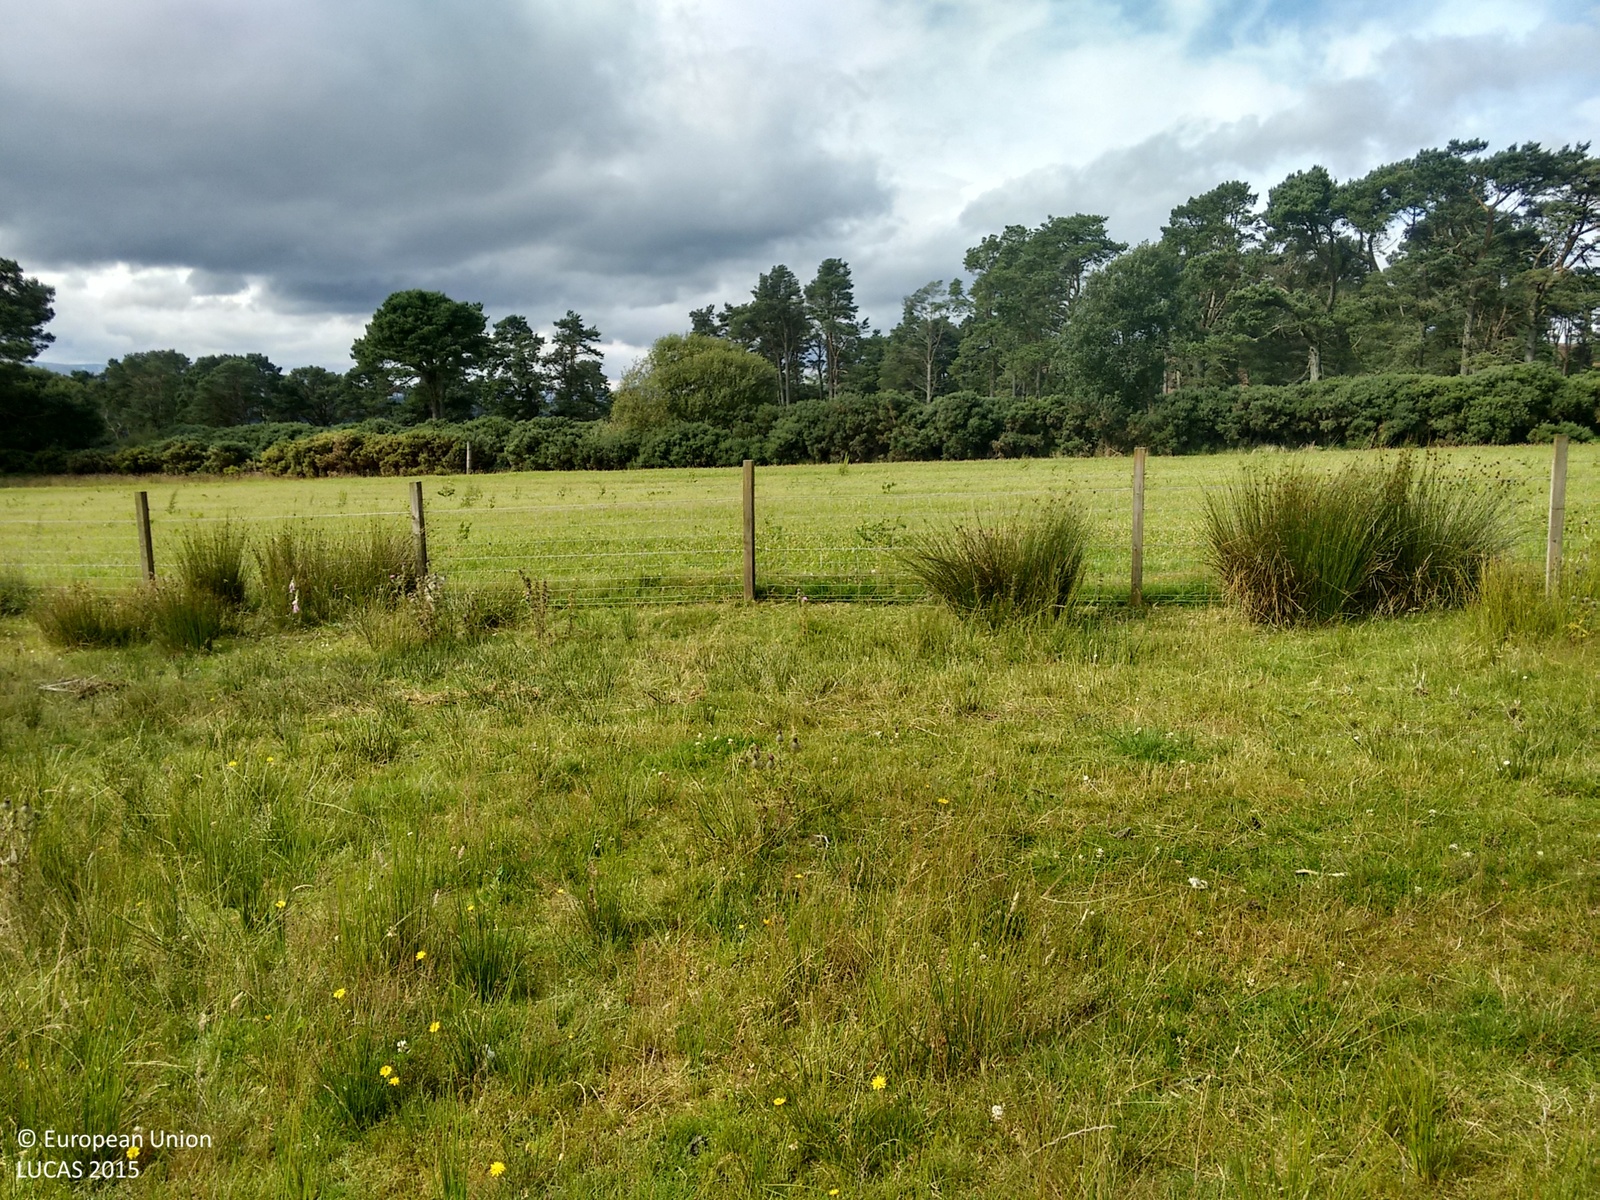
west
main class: Grassland
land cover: Grassland without tree/shrub cover
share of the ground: > 75 %
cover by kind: herbaceous plants 100 %
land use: Agriculture (excluding fallow land and kitchen gardens)
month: August
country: GB
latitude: 57.9097
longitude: -4.1048
